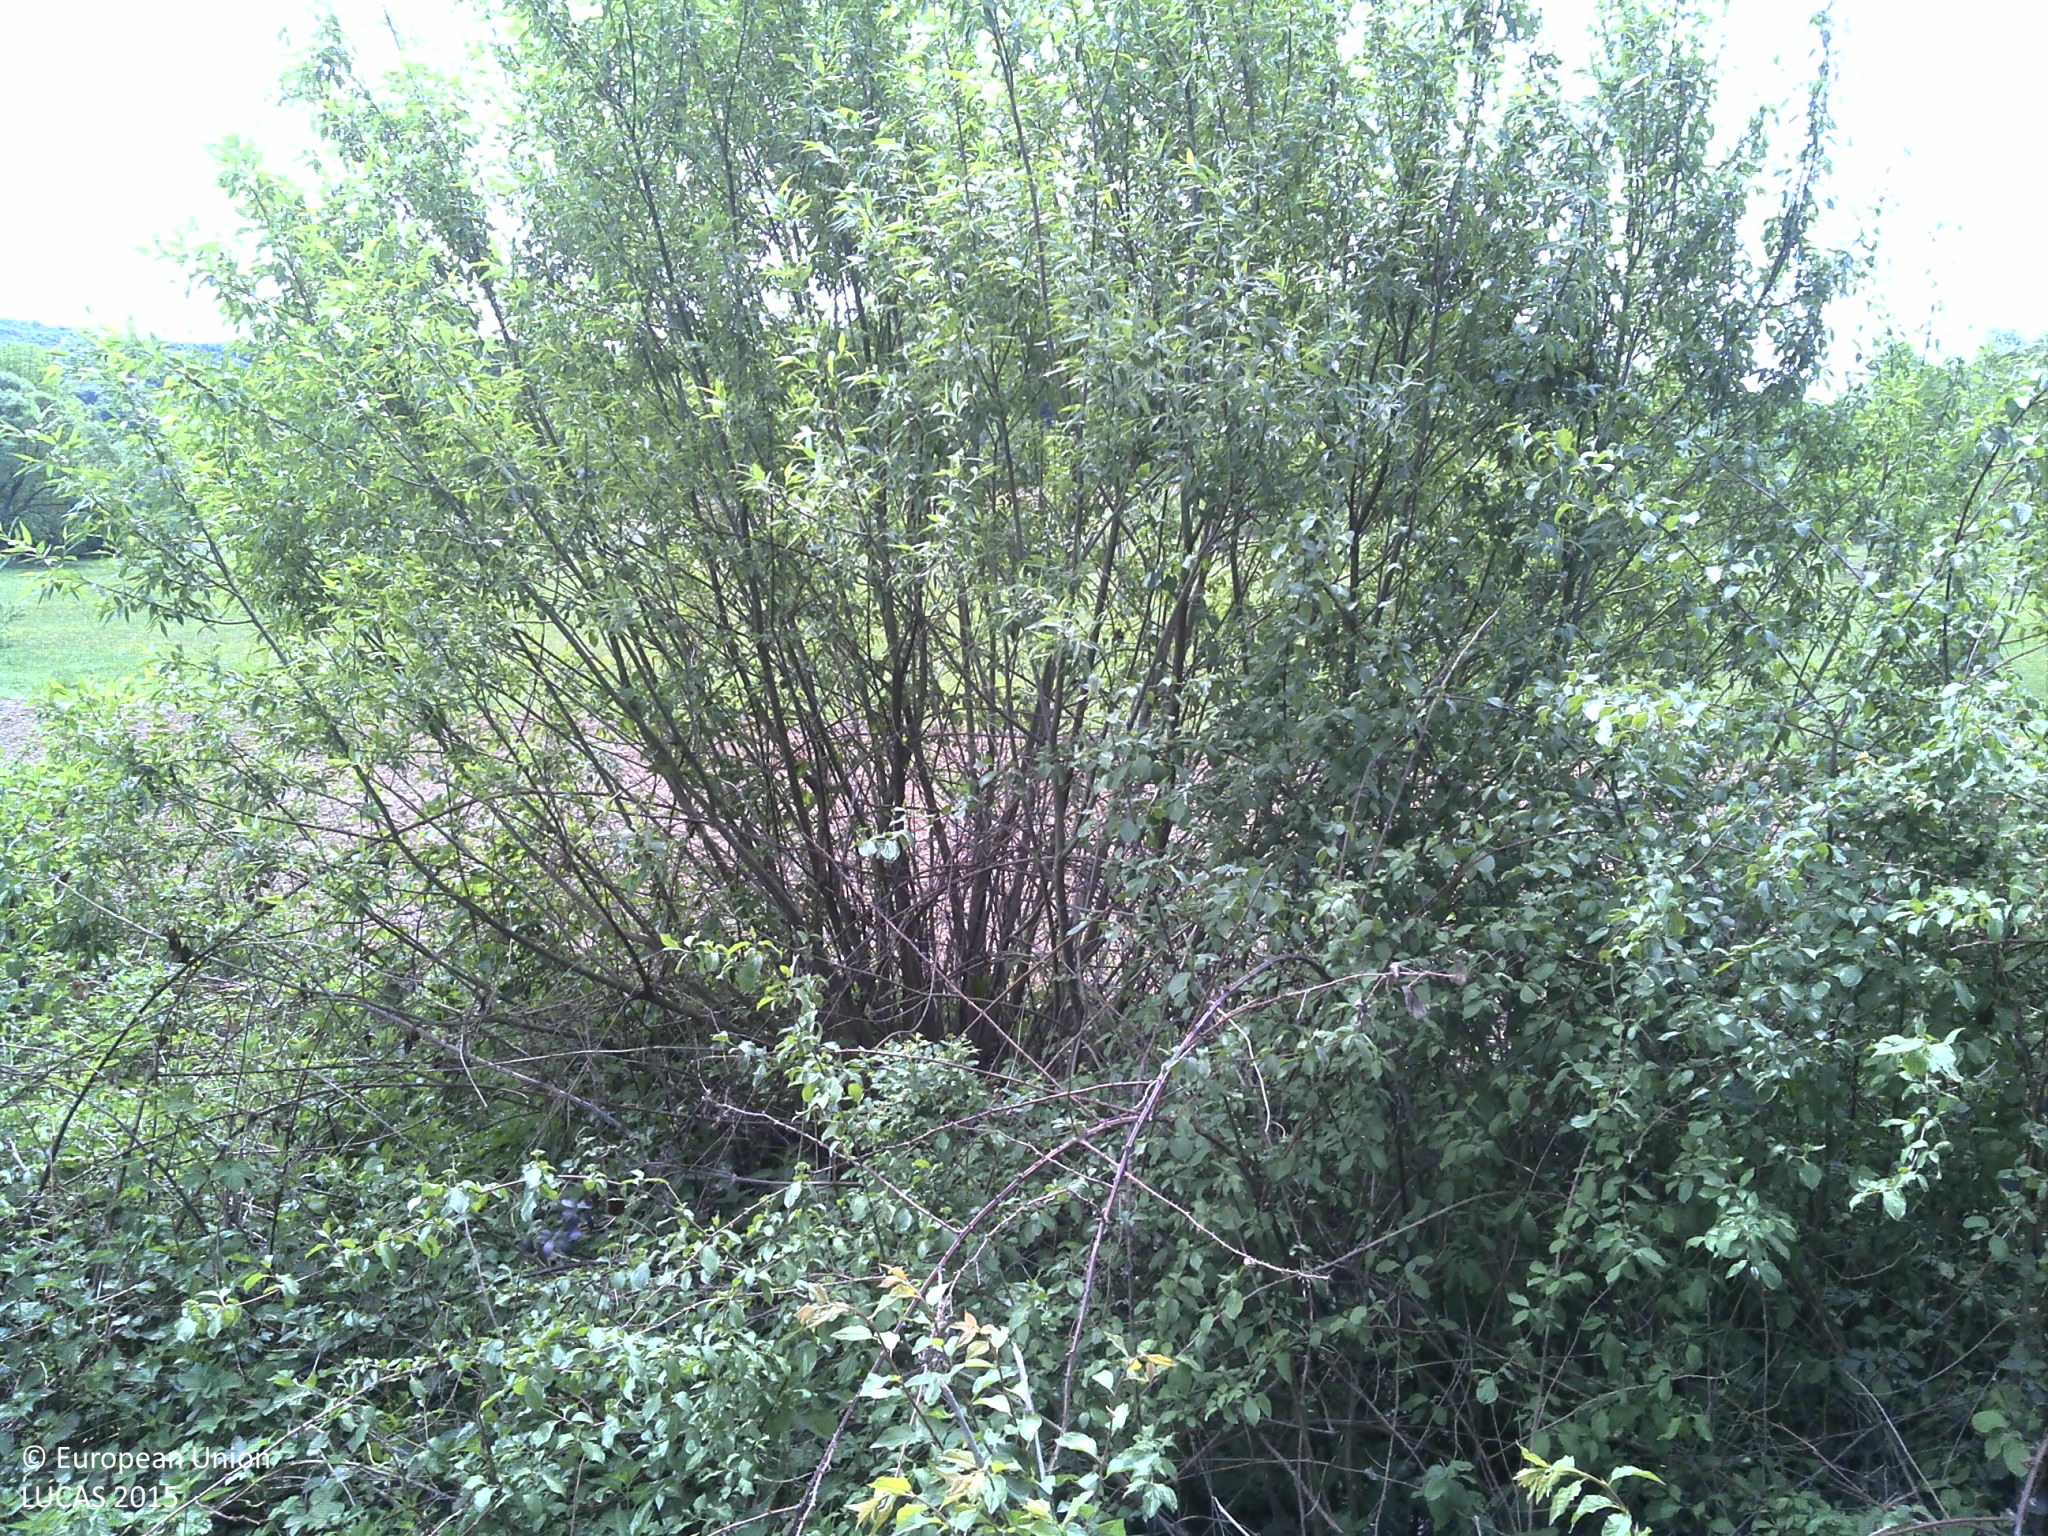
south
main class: Shrubland
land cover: Shrubland with sparse tree cover
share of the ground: > 75 %
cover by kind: shrubs 95 %, broadleaved forest trees 5 %
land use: Semi-natural and natural areas not in use
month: May
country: HR
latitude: 45.3332
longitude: 18.1575
